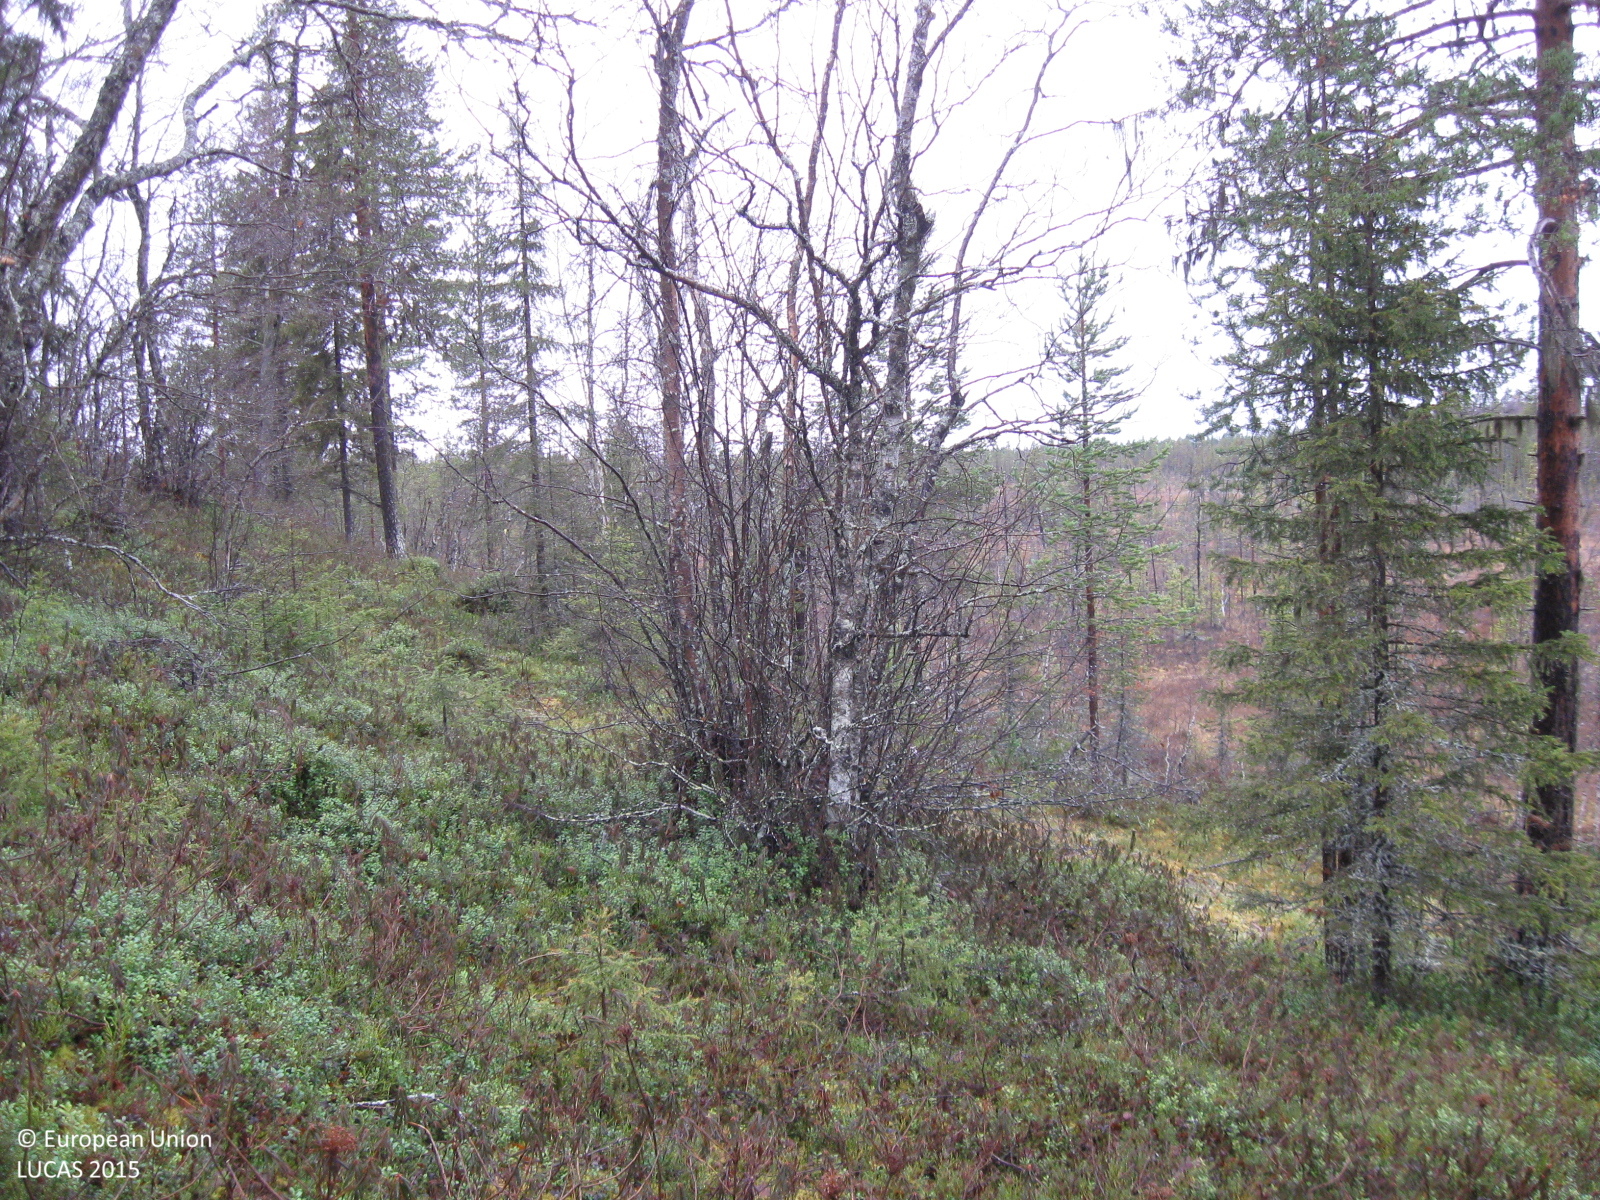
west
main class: Woodland
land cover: Spruce dominated mixed woodland
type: boreal forest
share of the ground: 50 - 75 %
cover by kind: shrubs 35 %, broadleaved forest trees 30 %, coniferous forest trees 20 %, herbaceous plants 10 %, lichens and mosses 5 %
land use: Forestry
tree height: > 5 m
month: October
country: SE
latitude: 66.5410
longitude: 20.9662
